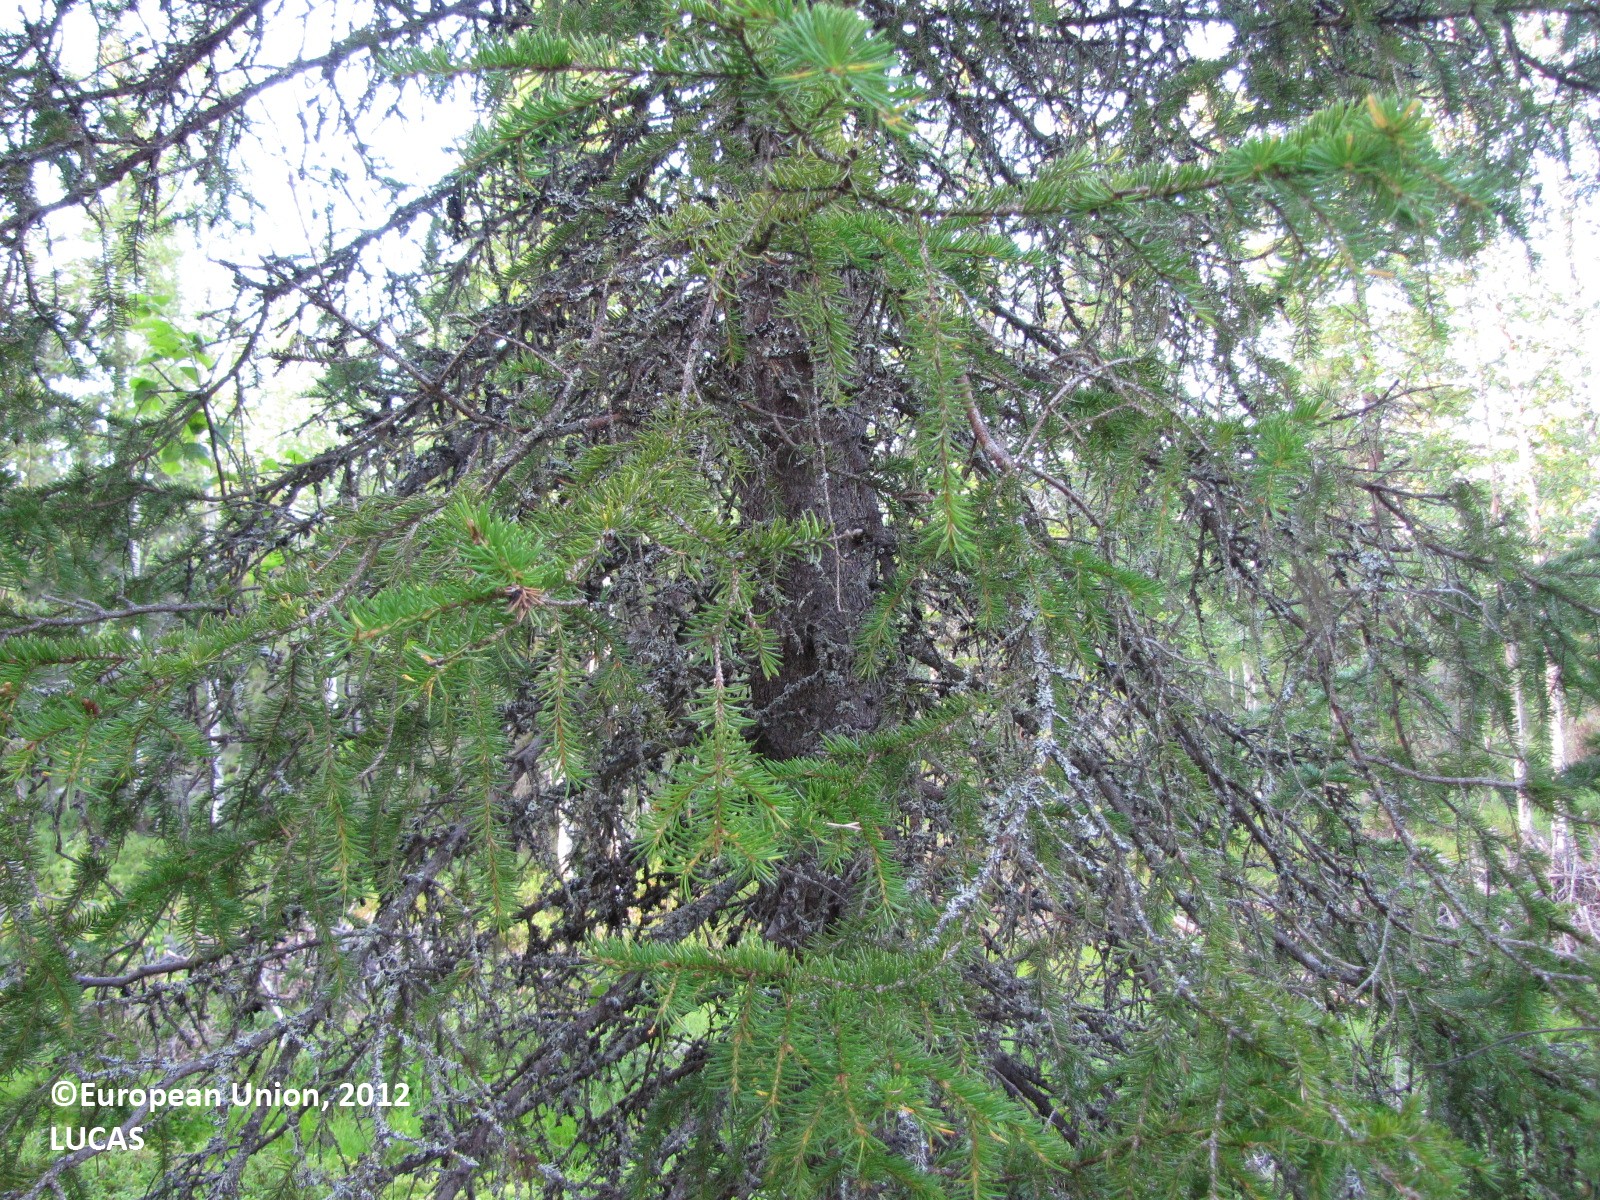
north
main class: Woodland
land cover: Spruce dominated mixed woodland
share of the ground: 25 - 50 %
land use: Forestry
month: August
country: FI
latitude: 66.8040
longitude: 24.9973
